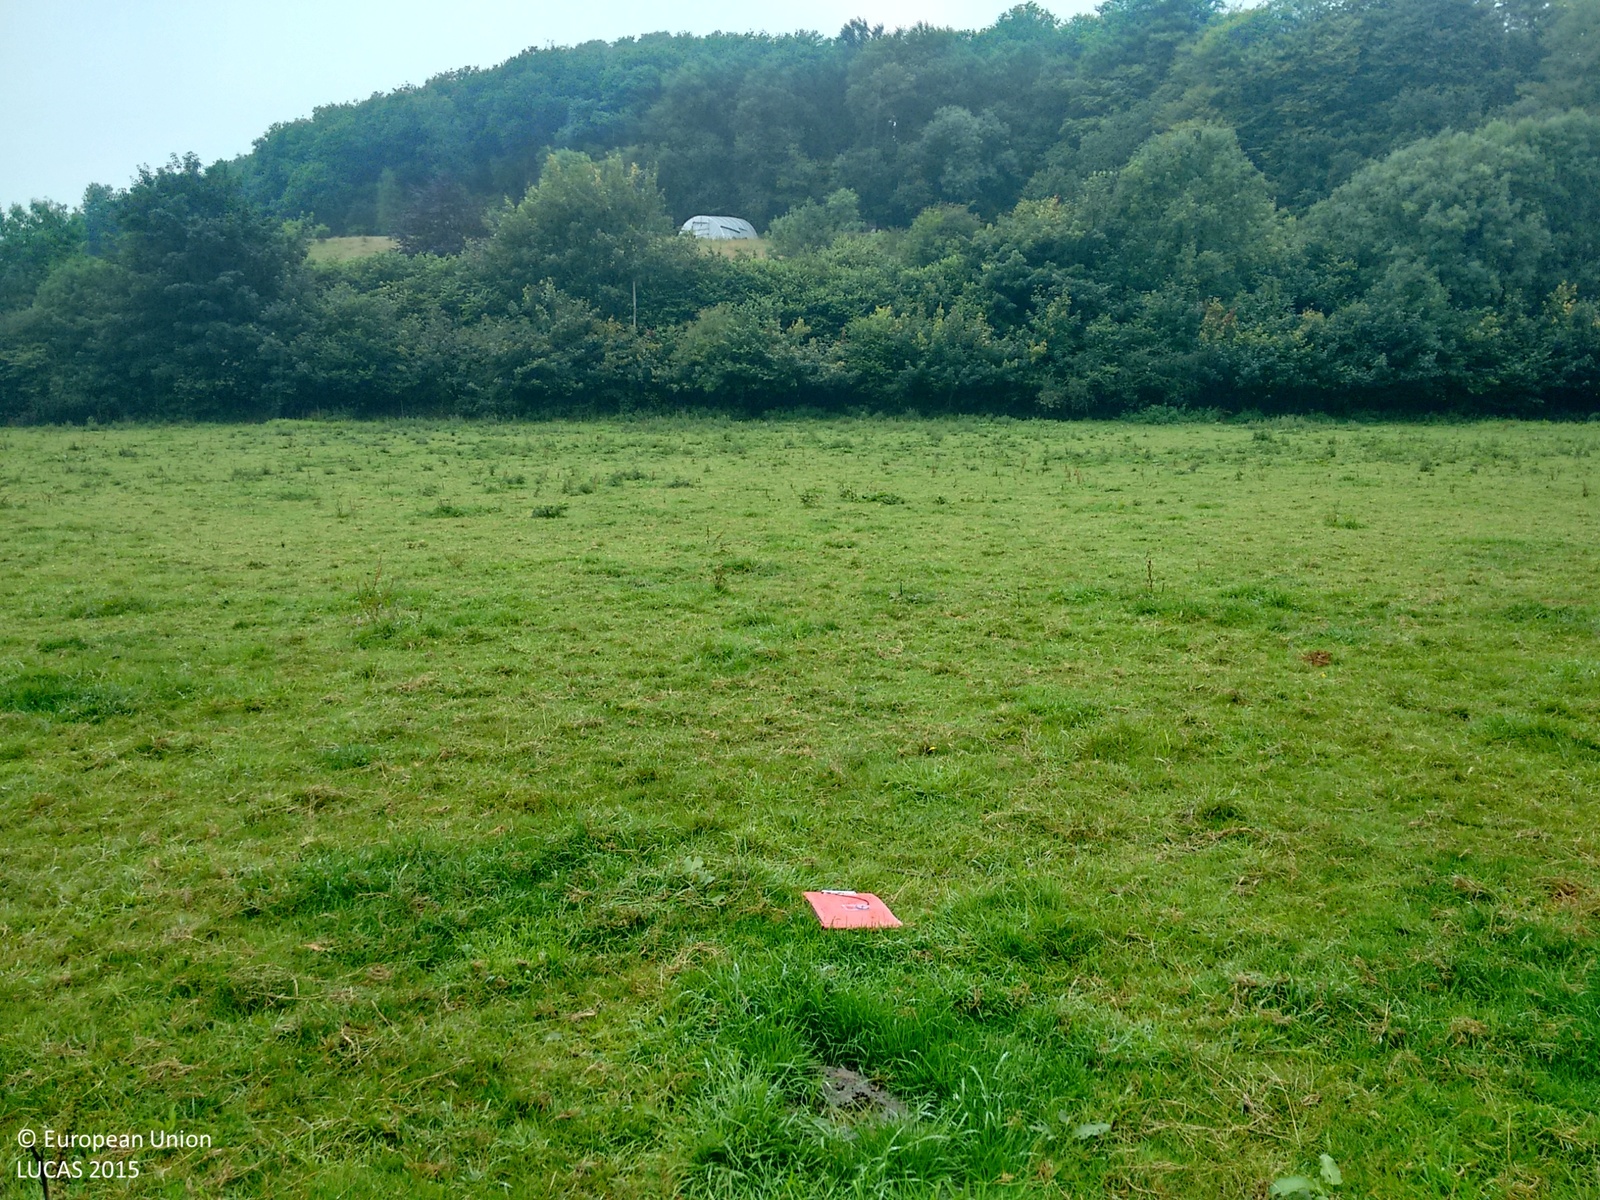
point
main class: Grassland
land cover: Grassland without tree/shrub cover
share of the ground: > 75 %
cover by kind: herbaceous plants 100 %
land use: Agriculture (excluding fallow land and kitchen gardens)
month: August
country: GB
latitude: 50.5185
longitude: -4.1585
